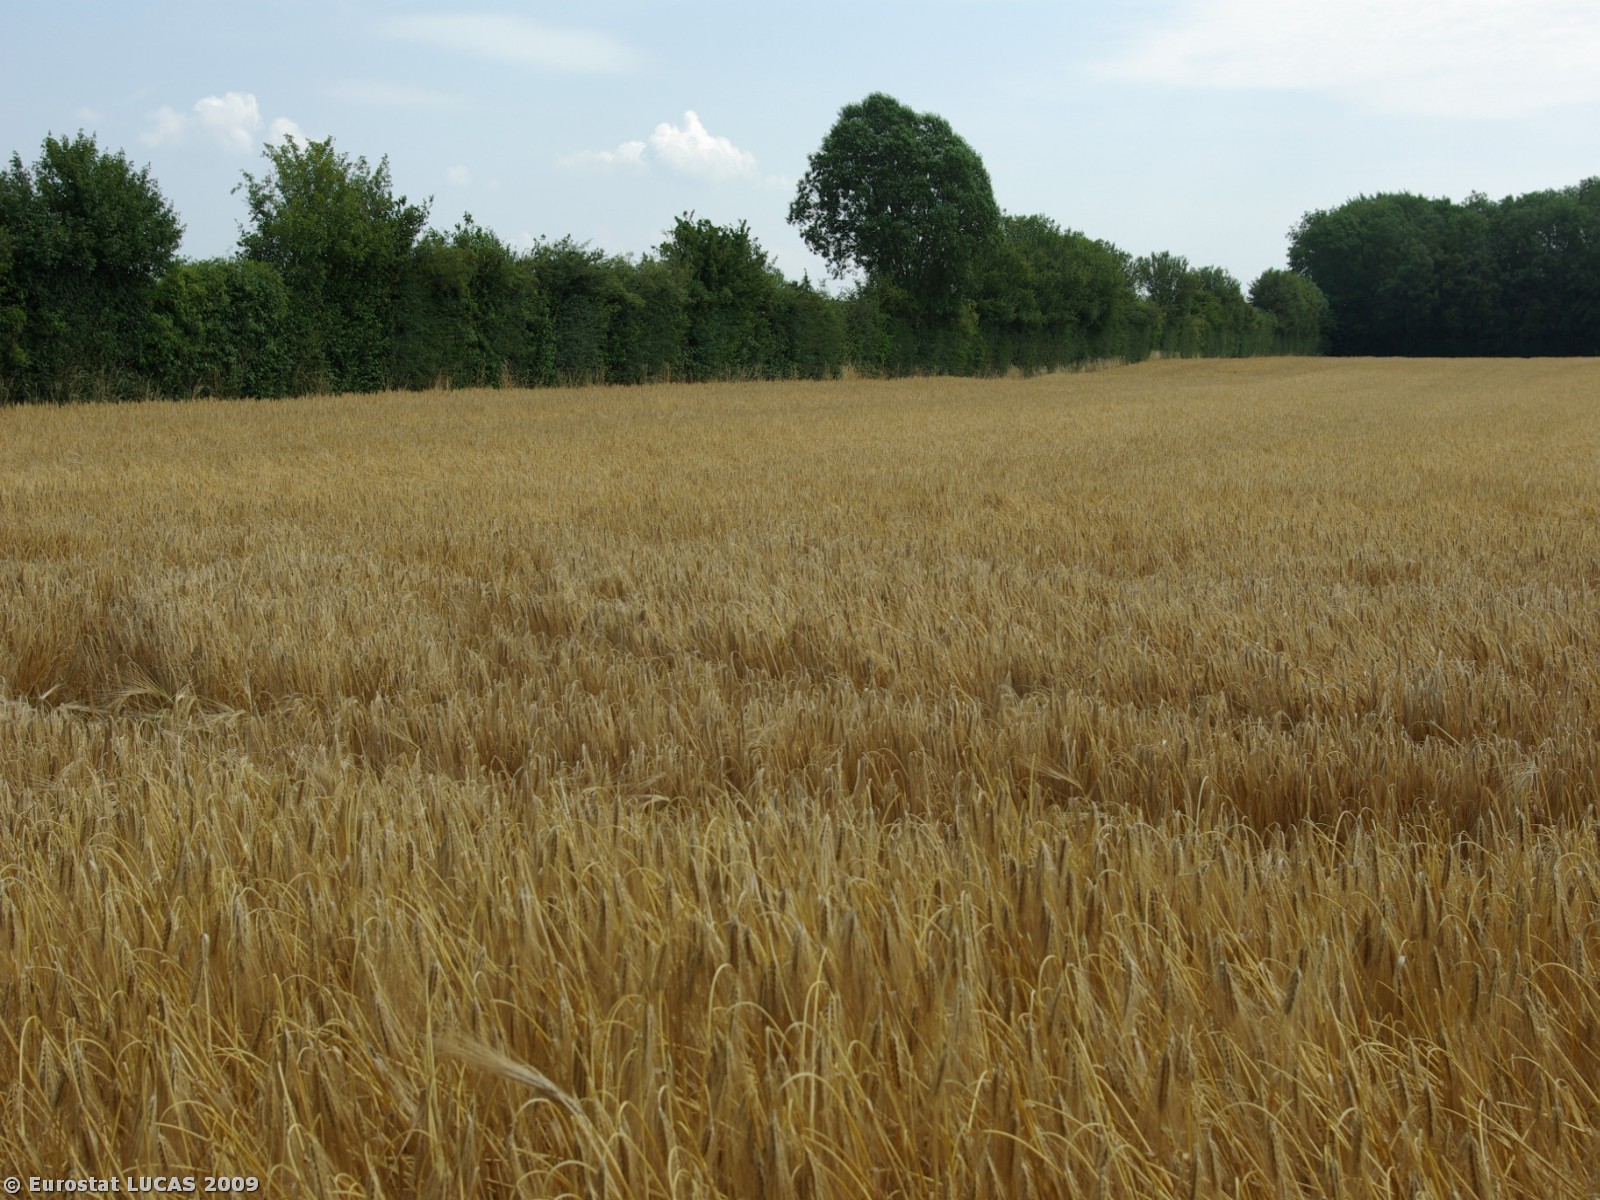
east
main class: Cropland
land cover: Barley
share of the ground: > 75 %
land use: Agriculture (excluding fallow land and kitchen gardens)
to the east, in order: Barley; Broadleaved woodland; Tracks; Grass margins; Barley; Tracks; Artificial constructions in urban areas
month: July
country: DK
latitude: 54.8936
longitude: 10.0467
